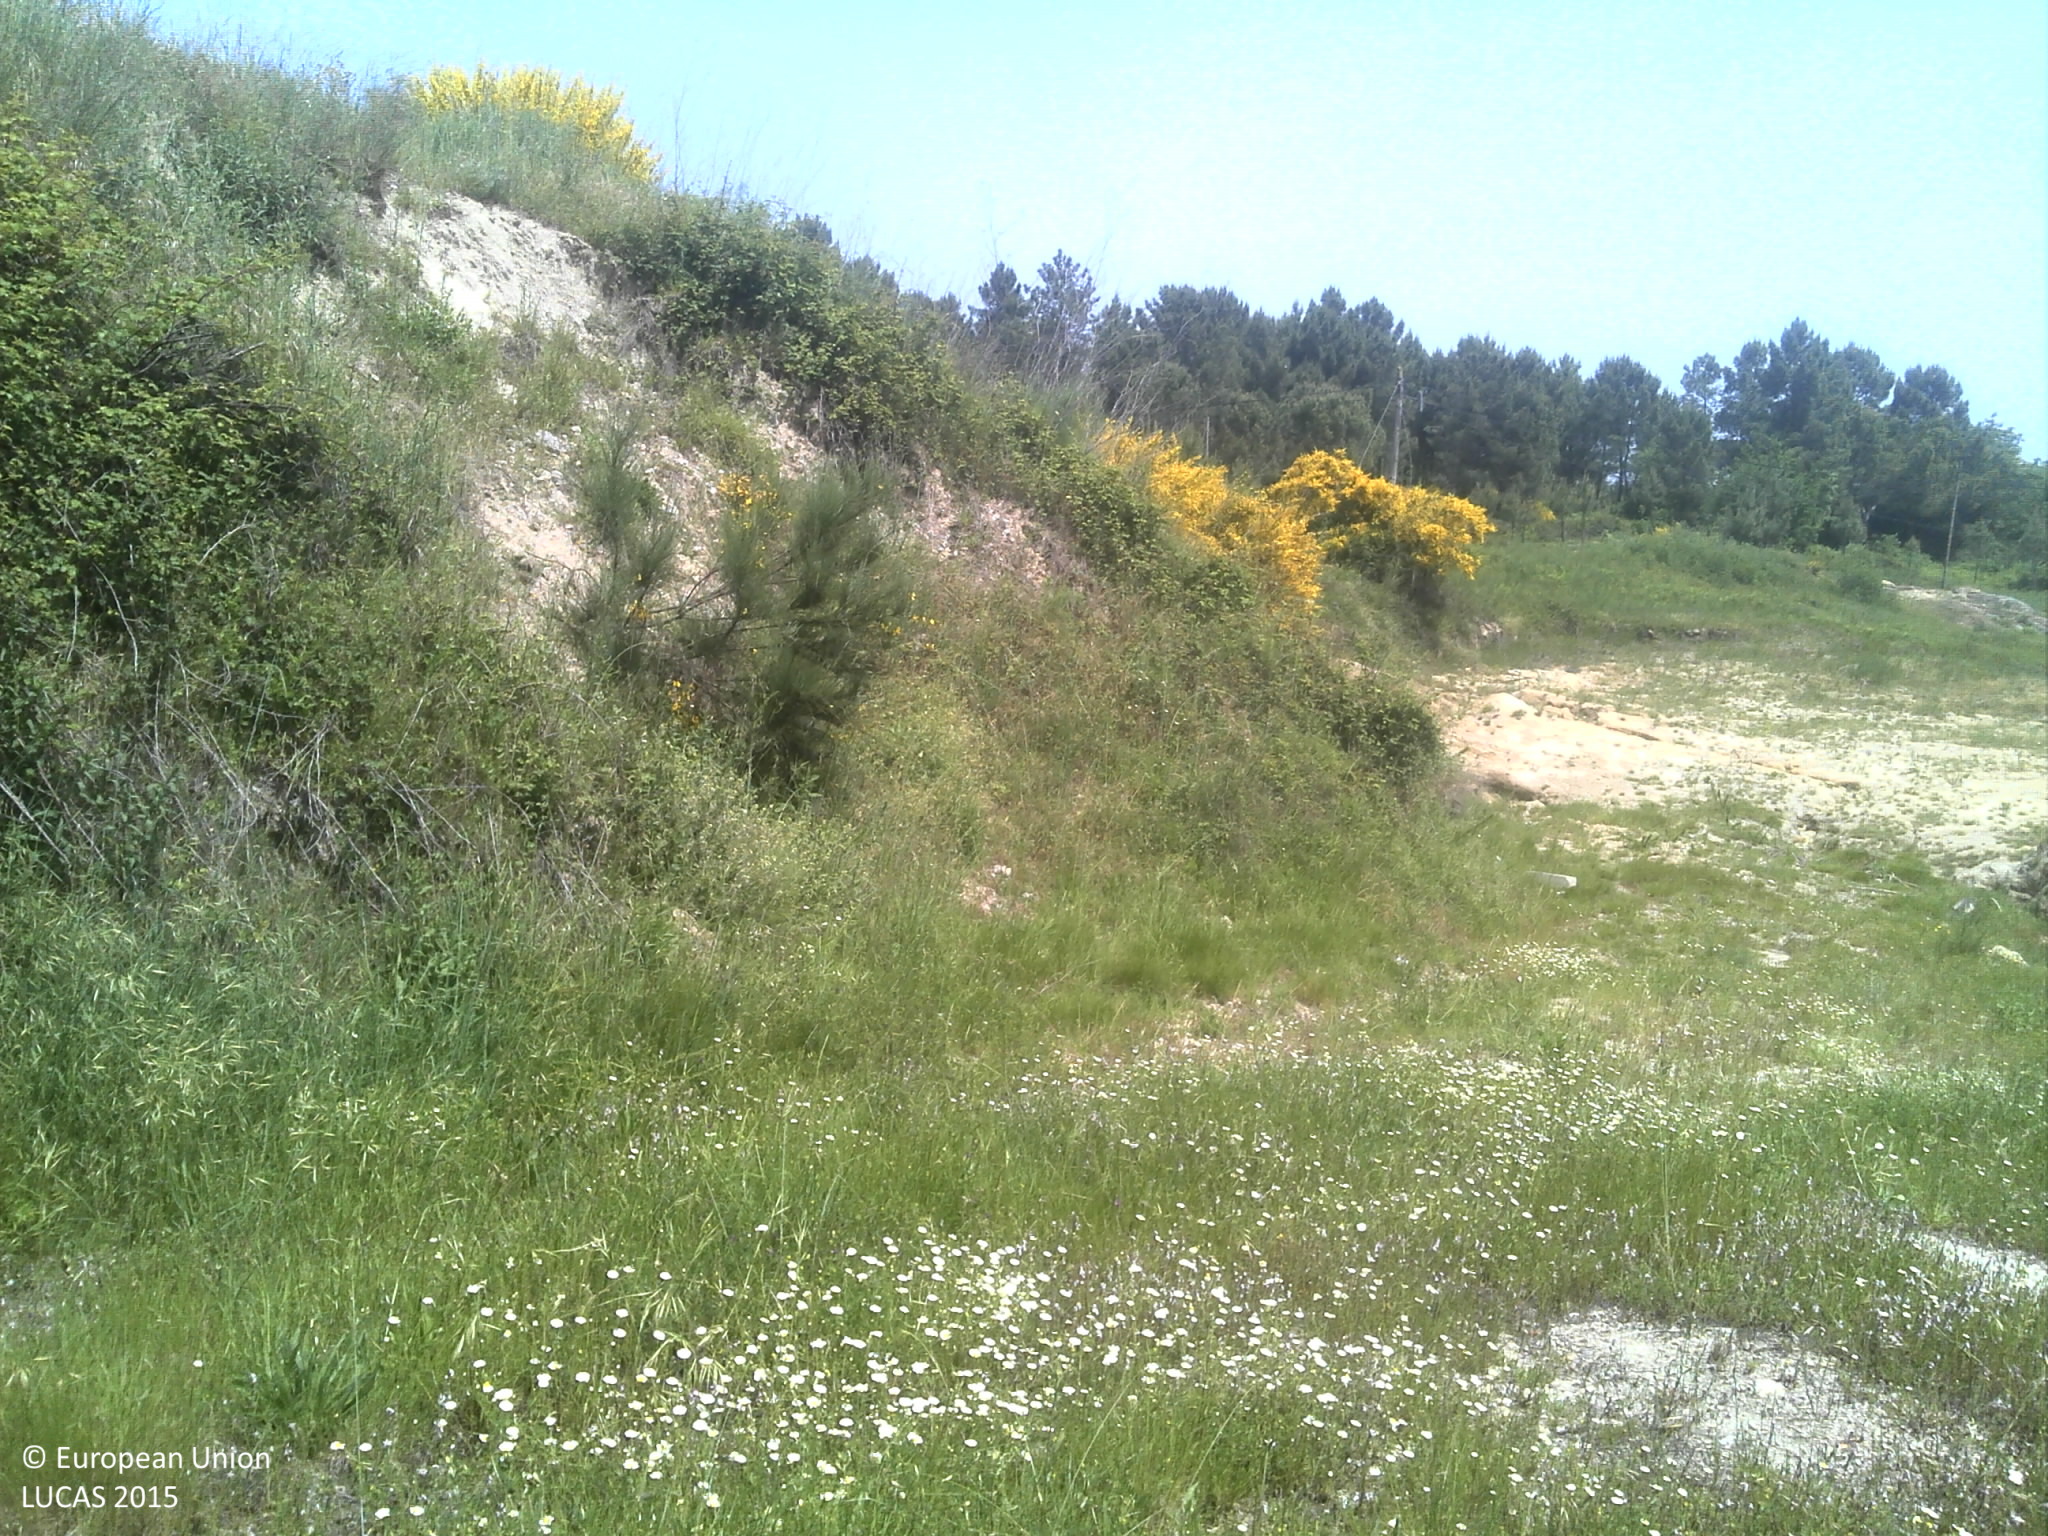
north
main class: Shrubland
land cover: Shrubland without tree cover
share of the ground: 25 - 50 %
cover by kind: shrubs 65 %, herbaceous plants 20 %, consolidated bare surface 15 %
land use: Abandoned areas
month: May
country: PT
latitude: 40.5898
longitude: -7.7598
